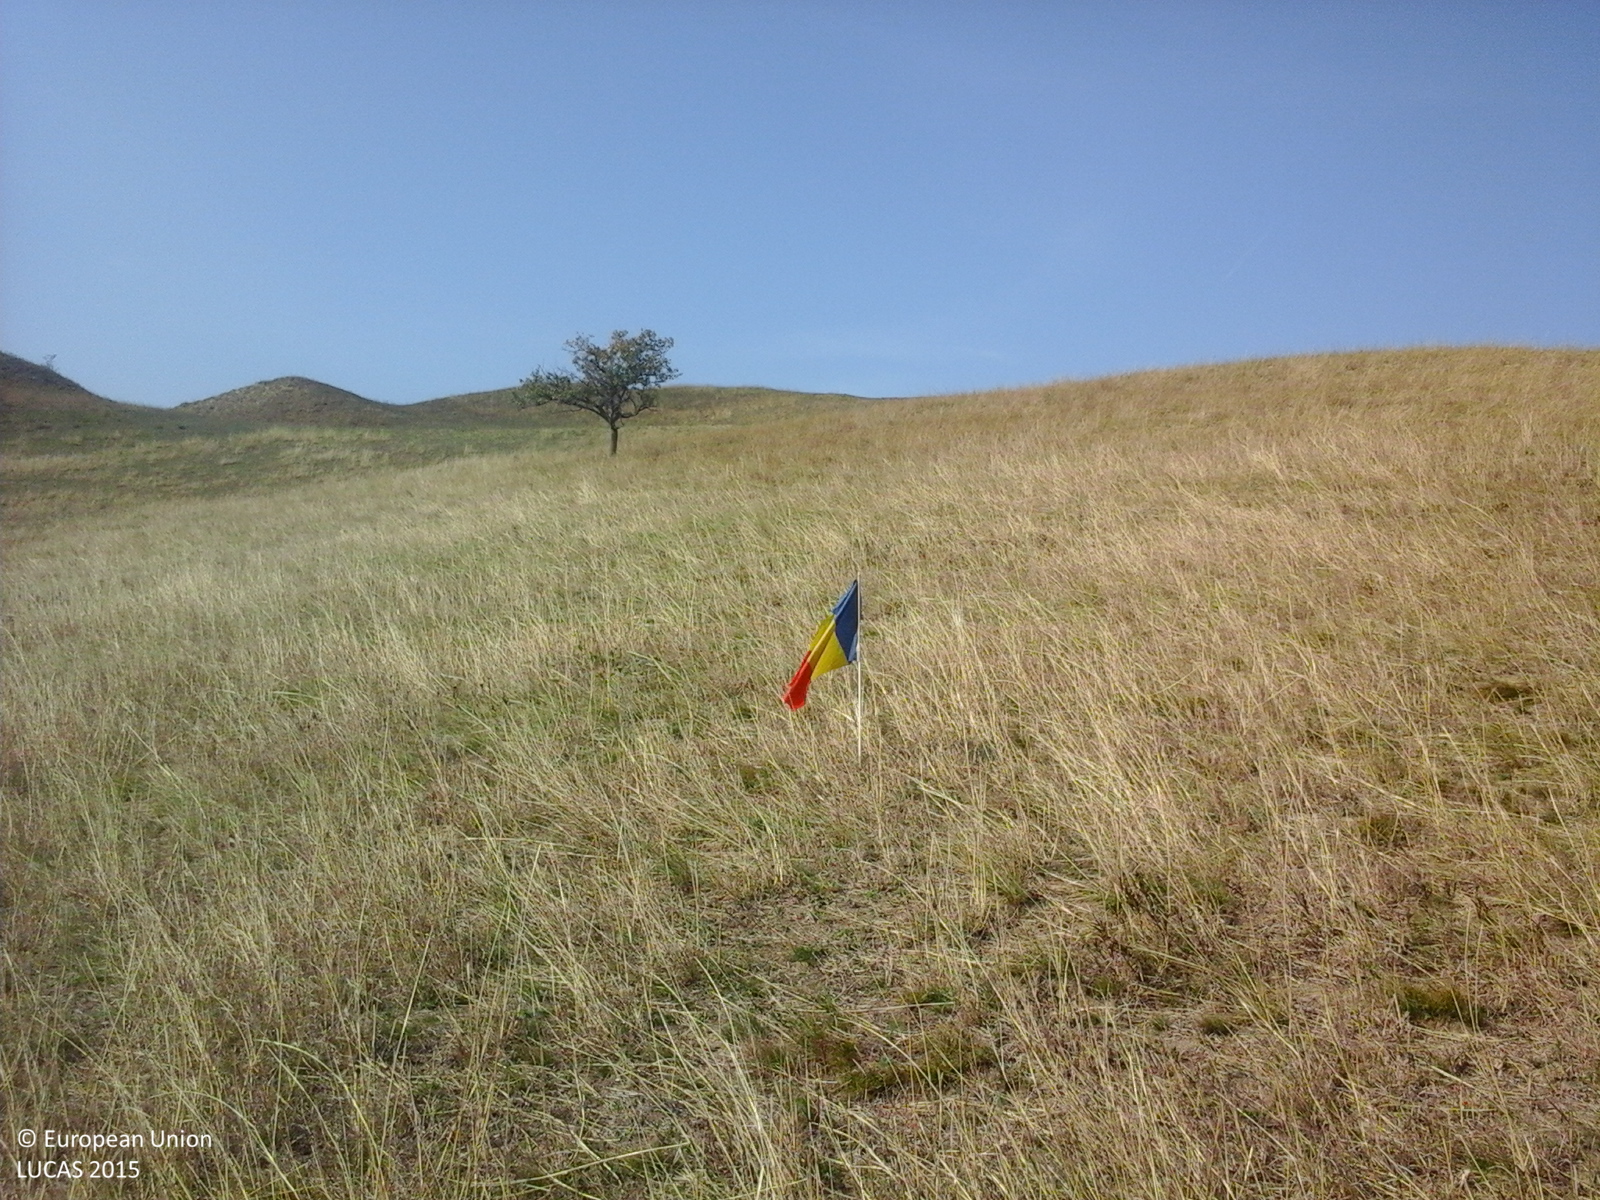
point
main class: Grassland
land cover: Grassland without tree/shrub cover
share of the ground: > 75 %
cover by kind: herbaceous plants 100 %
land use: Agriculture (excluding fallow land and kitchen gardens)
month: October
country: RO
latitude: 46.2935
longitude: 23.9250
